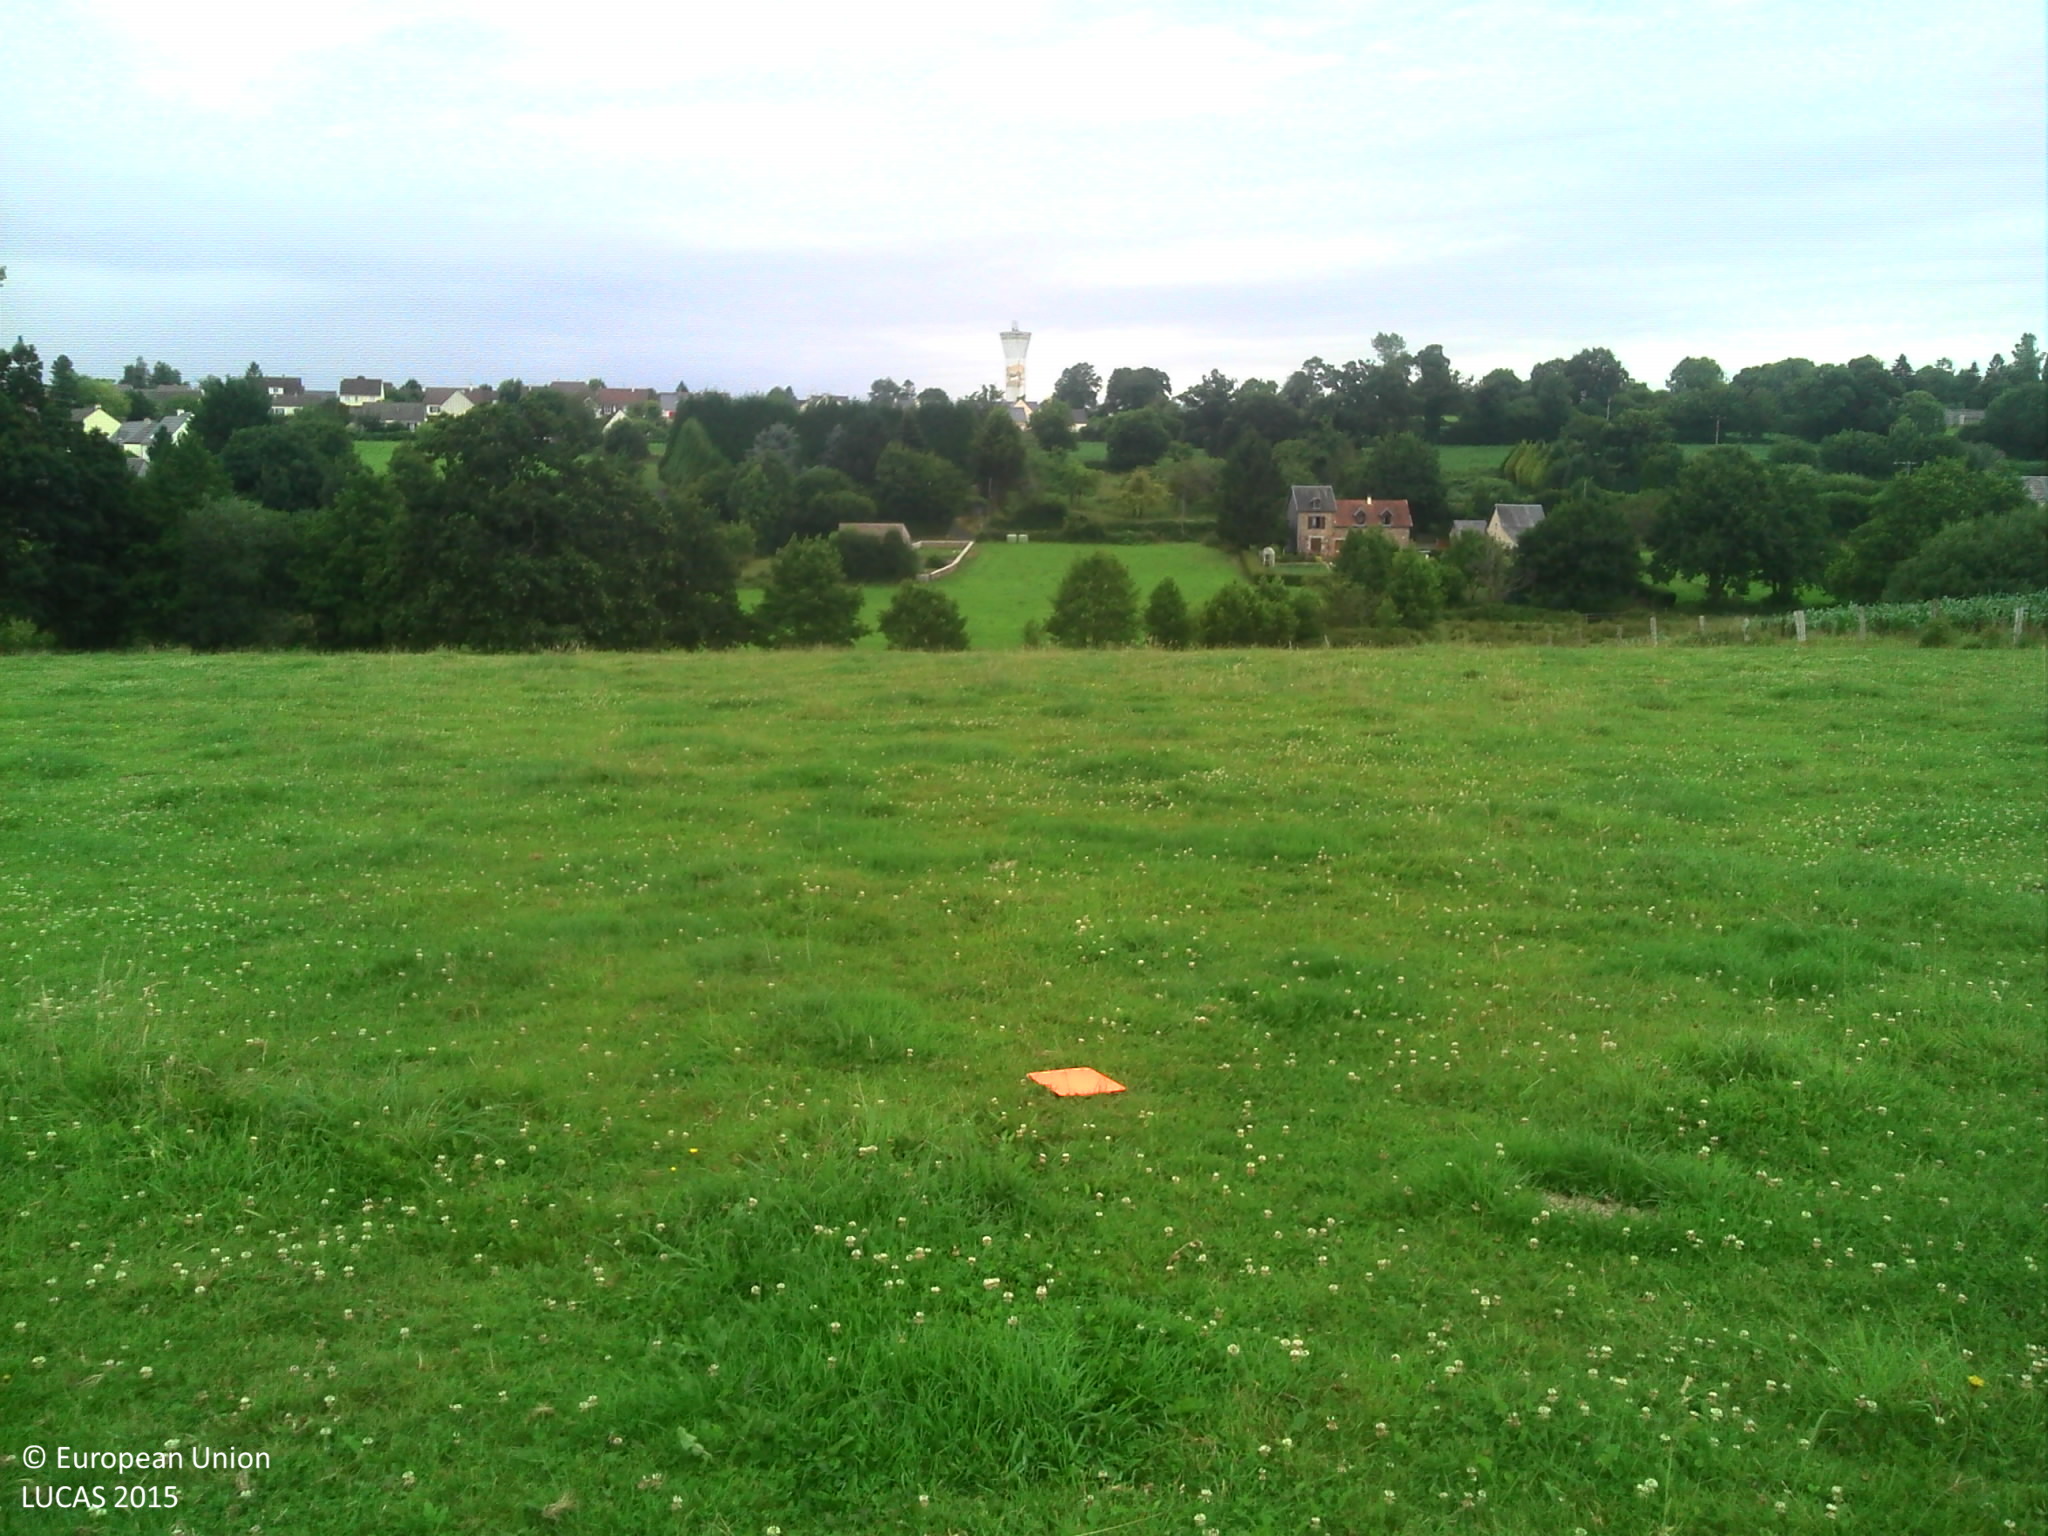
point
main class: Grassland
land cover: Grassland without tree/shrub cover
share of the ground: > 75 %
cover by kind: herbaceous plants 100 %
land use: Agriculture (excluding fallow land and kitchen gardens)
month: July
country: FR
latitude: 48.7943
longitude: -1.3858
